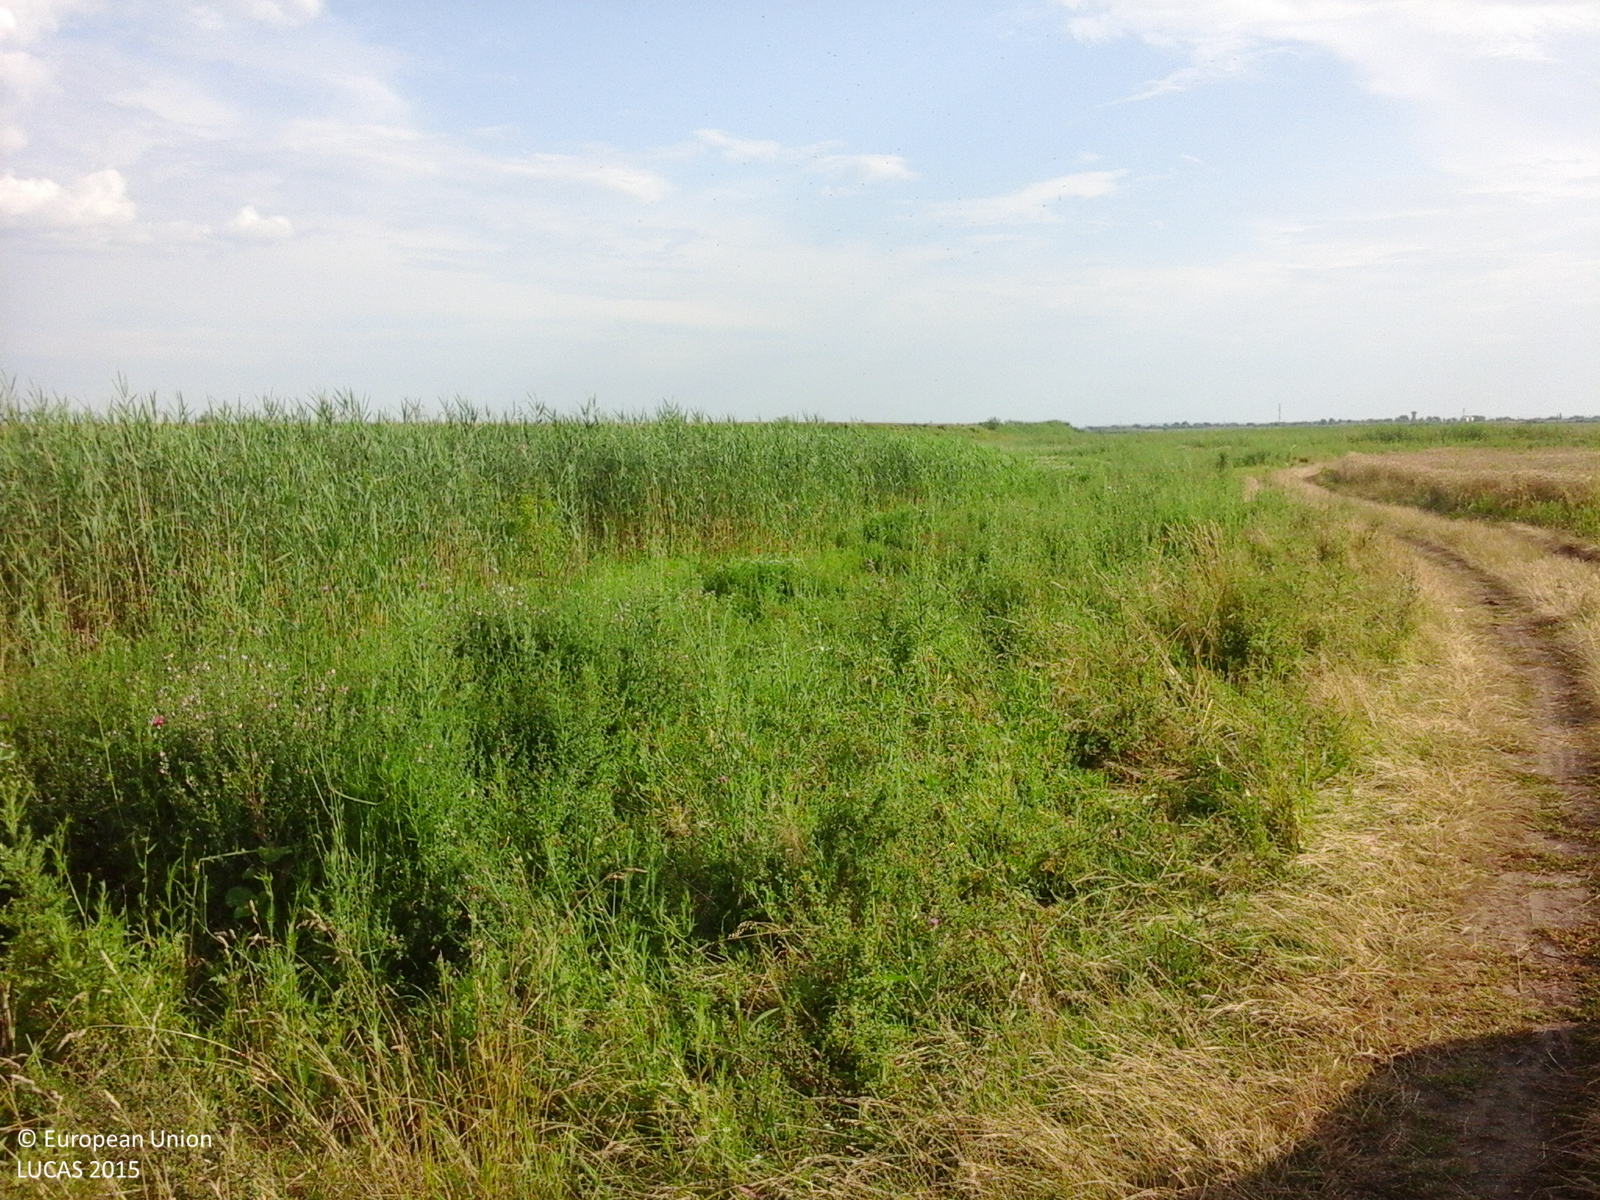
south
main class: Cropland
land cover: Common wheat
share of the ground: > 75 %
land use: Agriculture (excluding fallow land and kitchen gardens)
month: July
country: RO
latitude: 43.8425
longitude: 25.8266
